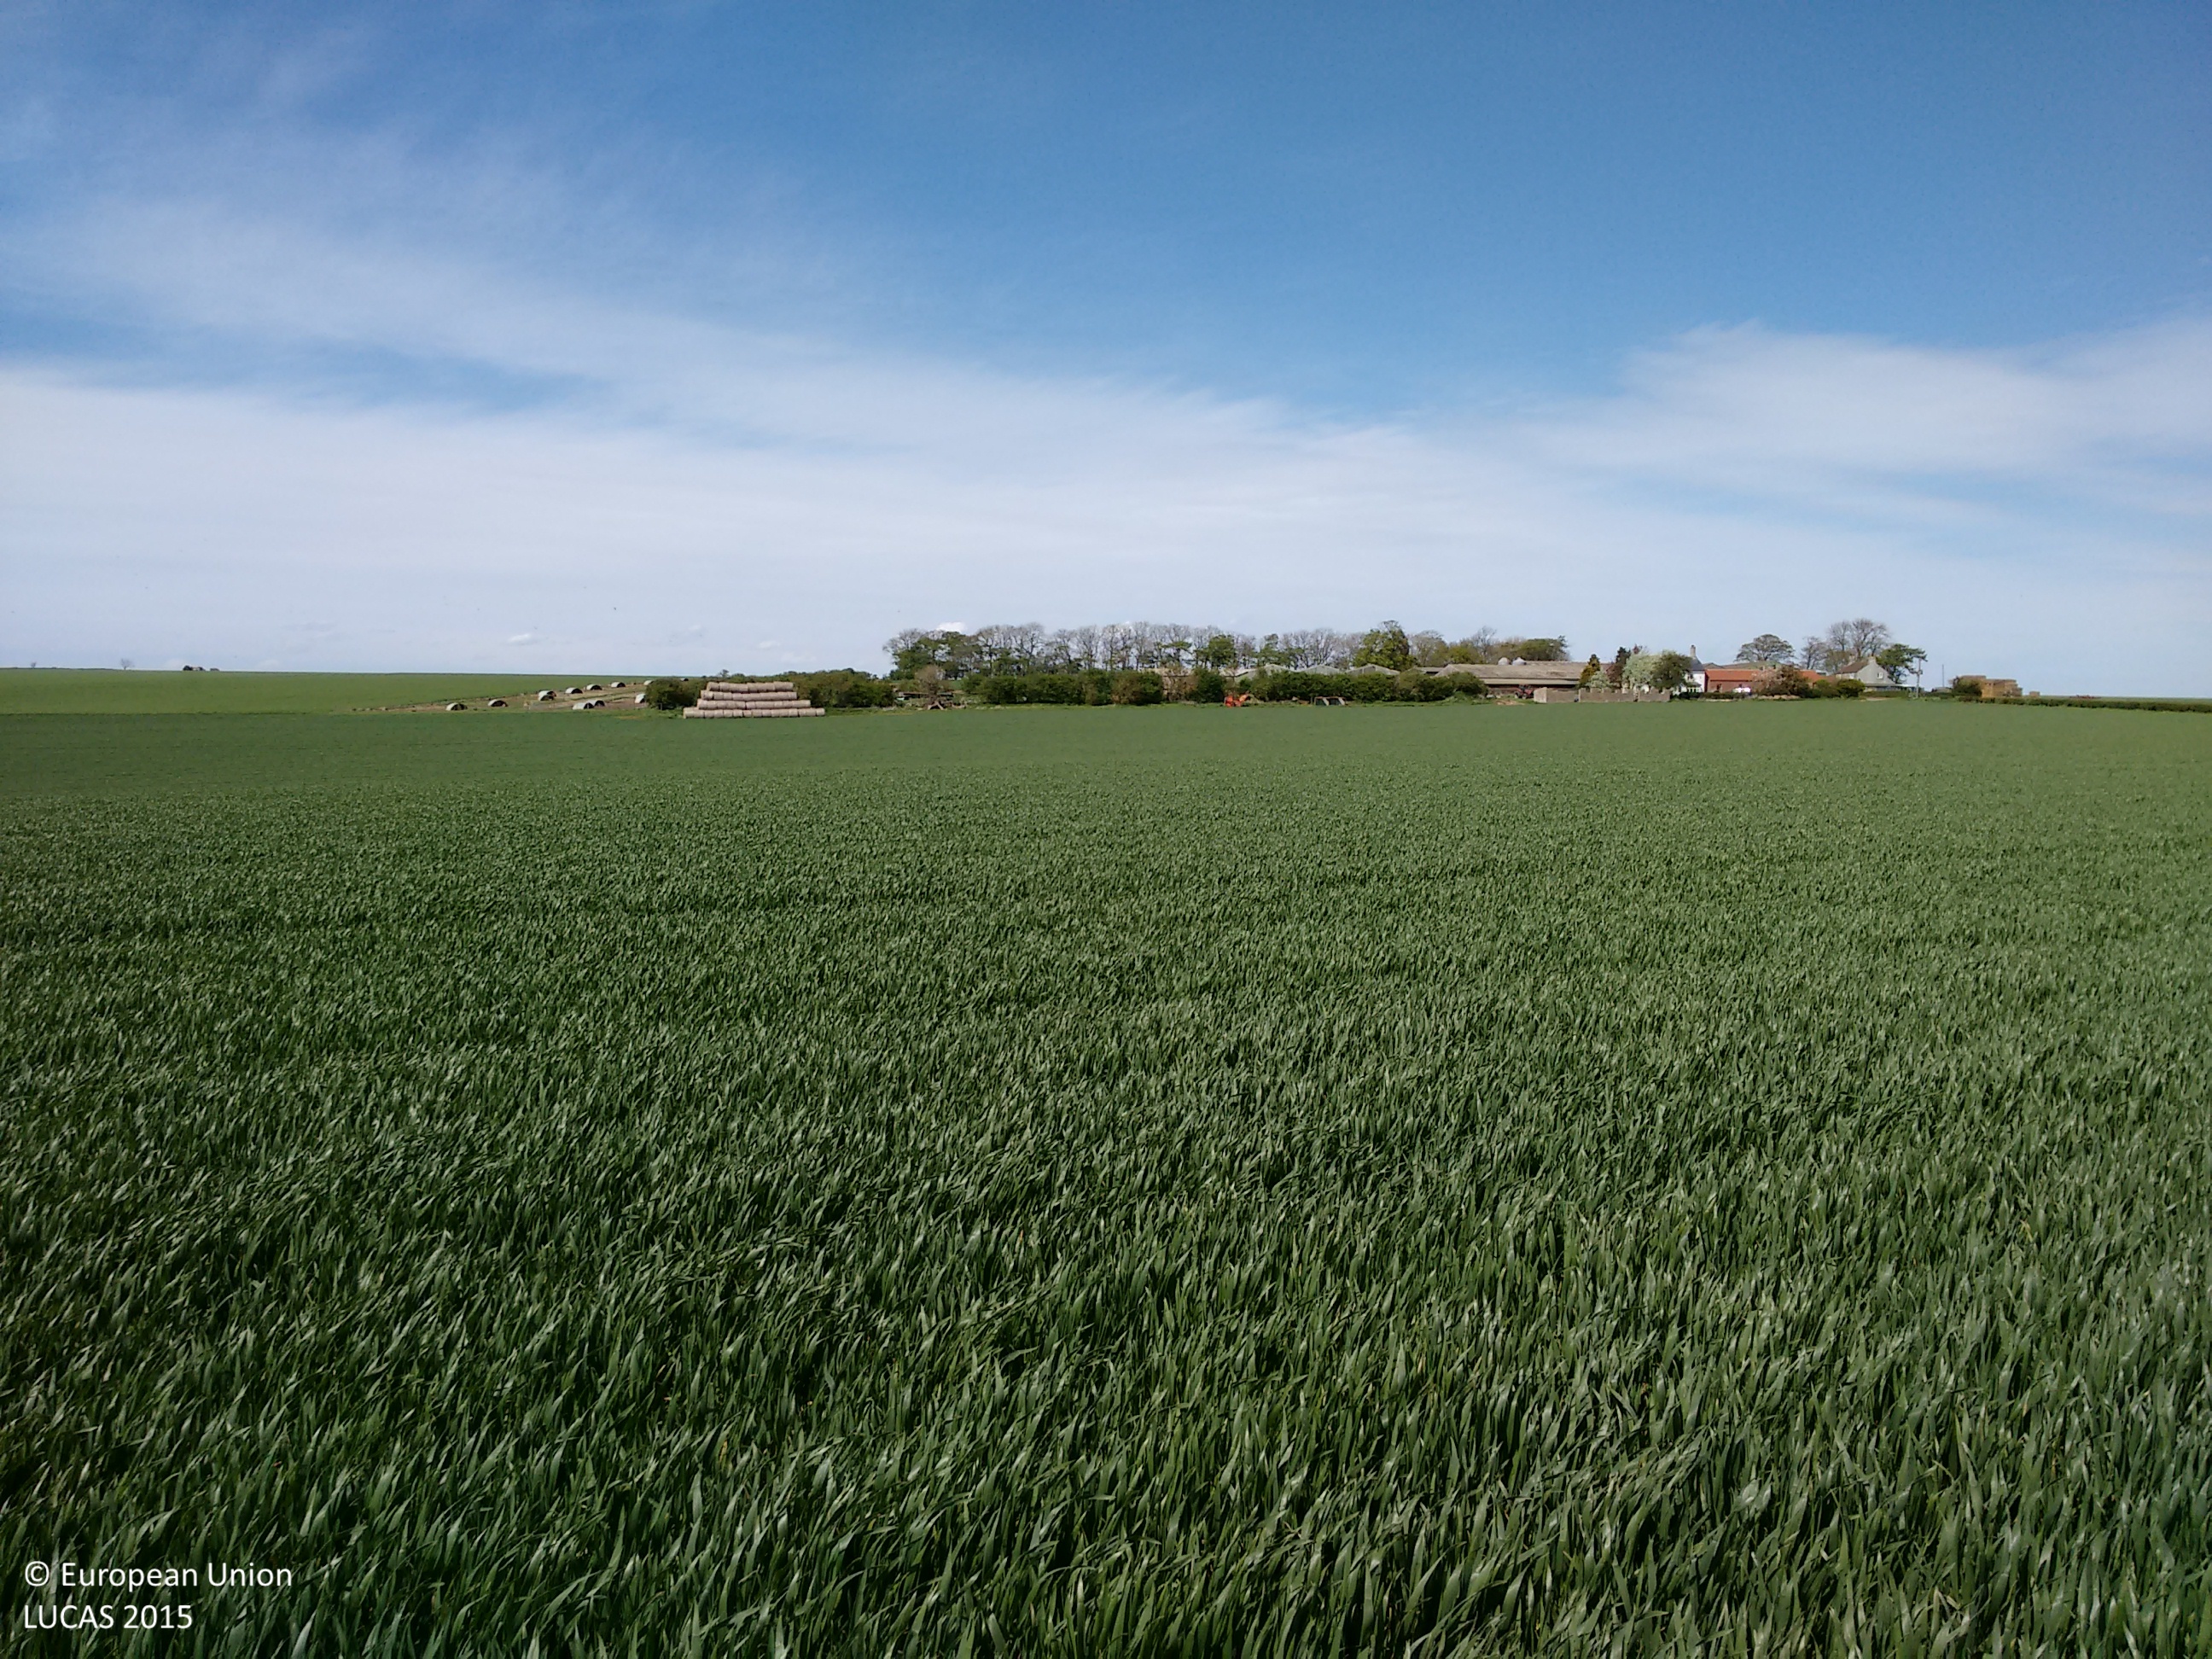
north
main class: Cropland
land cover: Common wheat
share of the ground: > 75 %
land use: Agriculture (excluding fallow land and kitchen gardens)
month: May
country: GB
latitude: 54.1167
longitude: -0.3613
